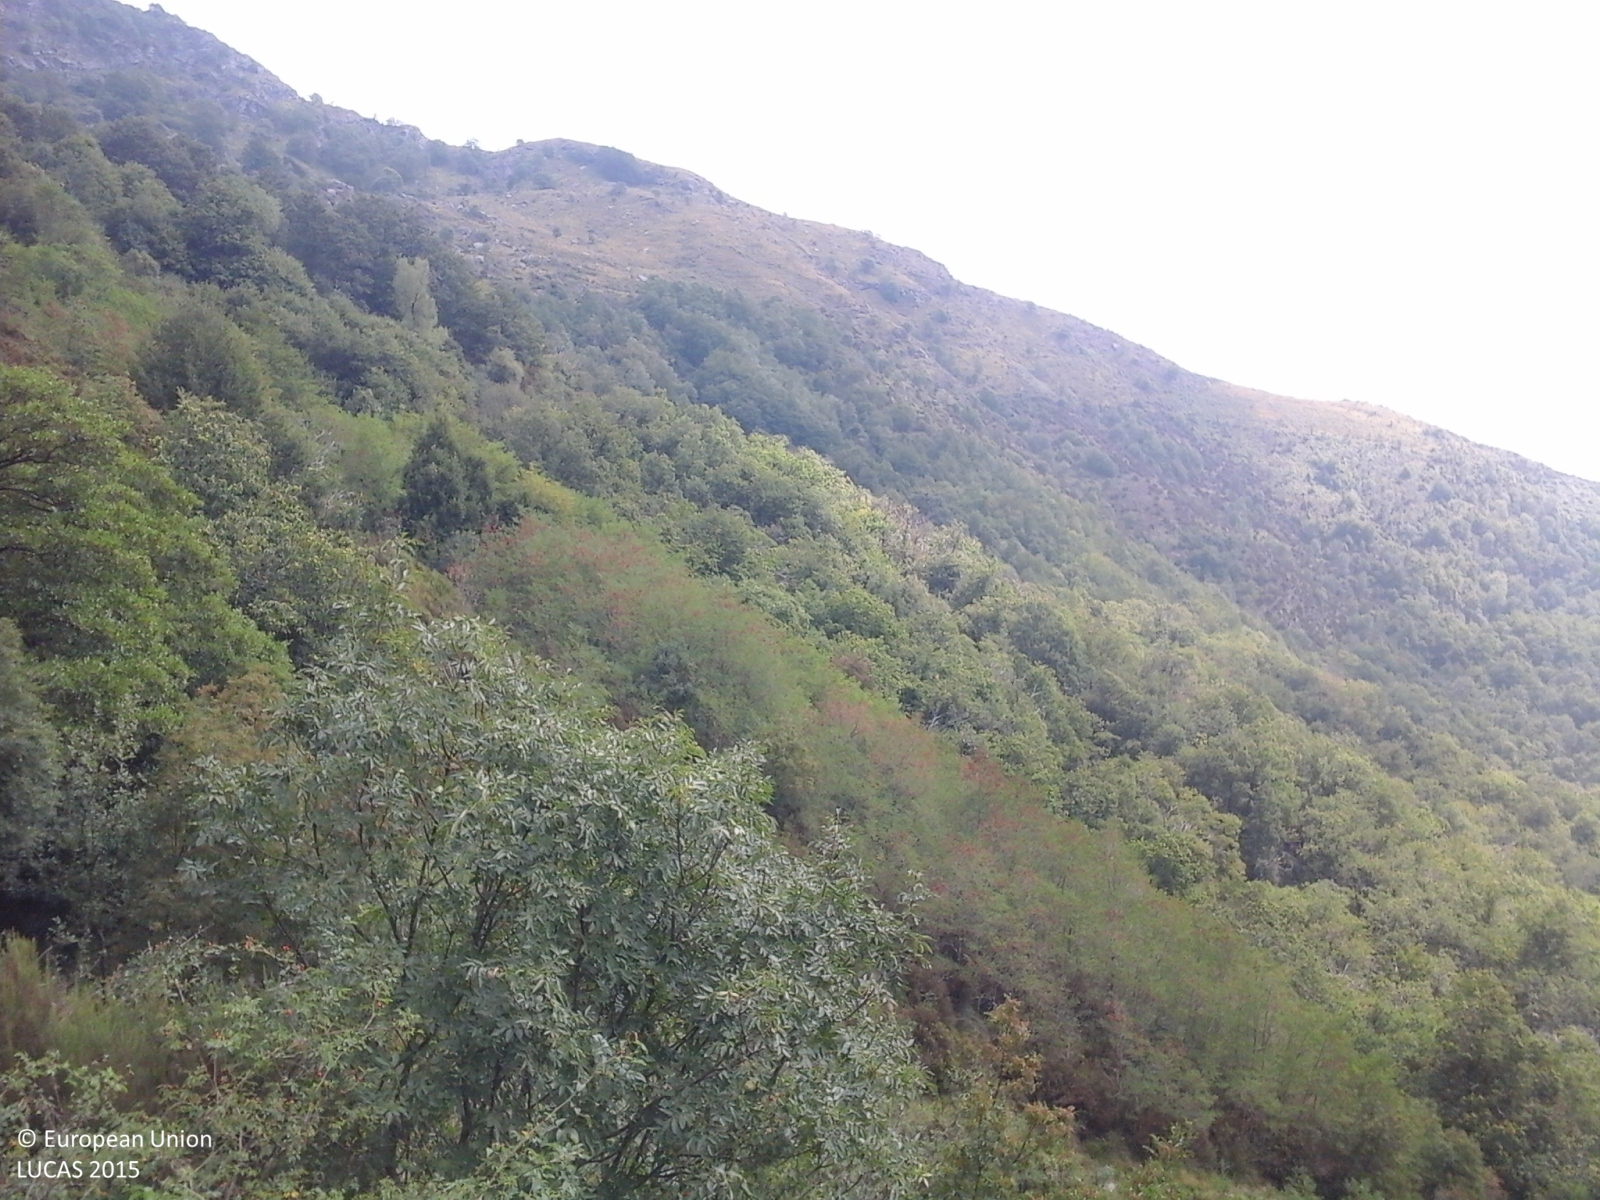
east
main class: Woodland
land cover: Broadleaved woodland
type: thermophilous deciduous forest
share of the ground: > 75 %
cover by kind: broadleaved forest trees 100 %
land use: Forestry
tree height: > 5 m
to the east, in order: Broadleaved woodland; Shrubland with sparse tree cover; Tracks; Shrubland with sparse tree cover
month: September
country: IT
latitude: 44.4558
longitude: 9.2100
